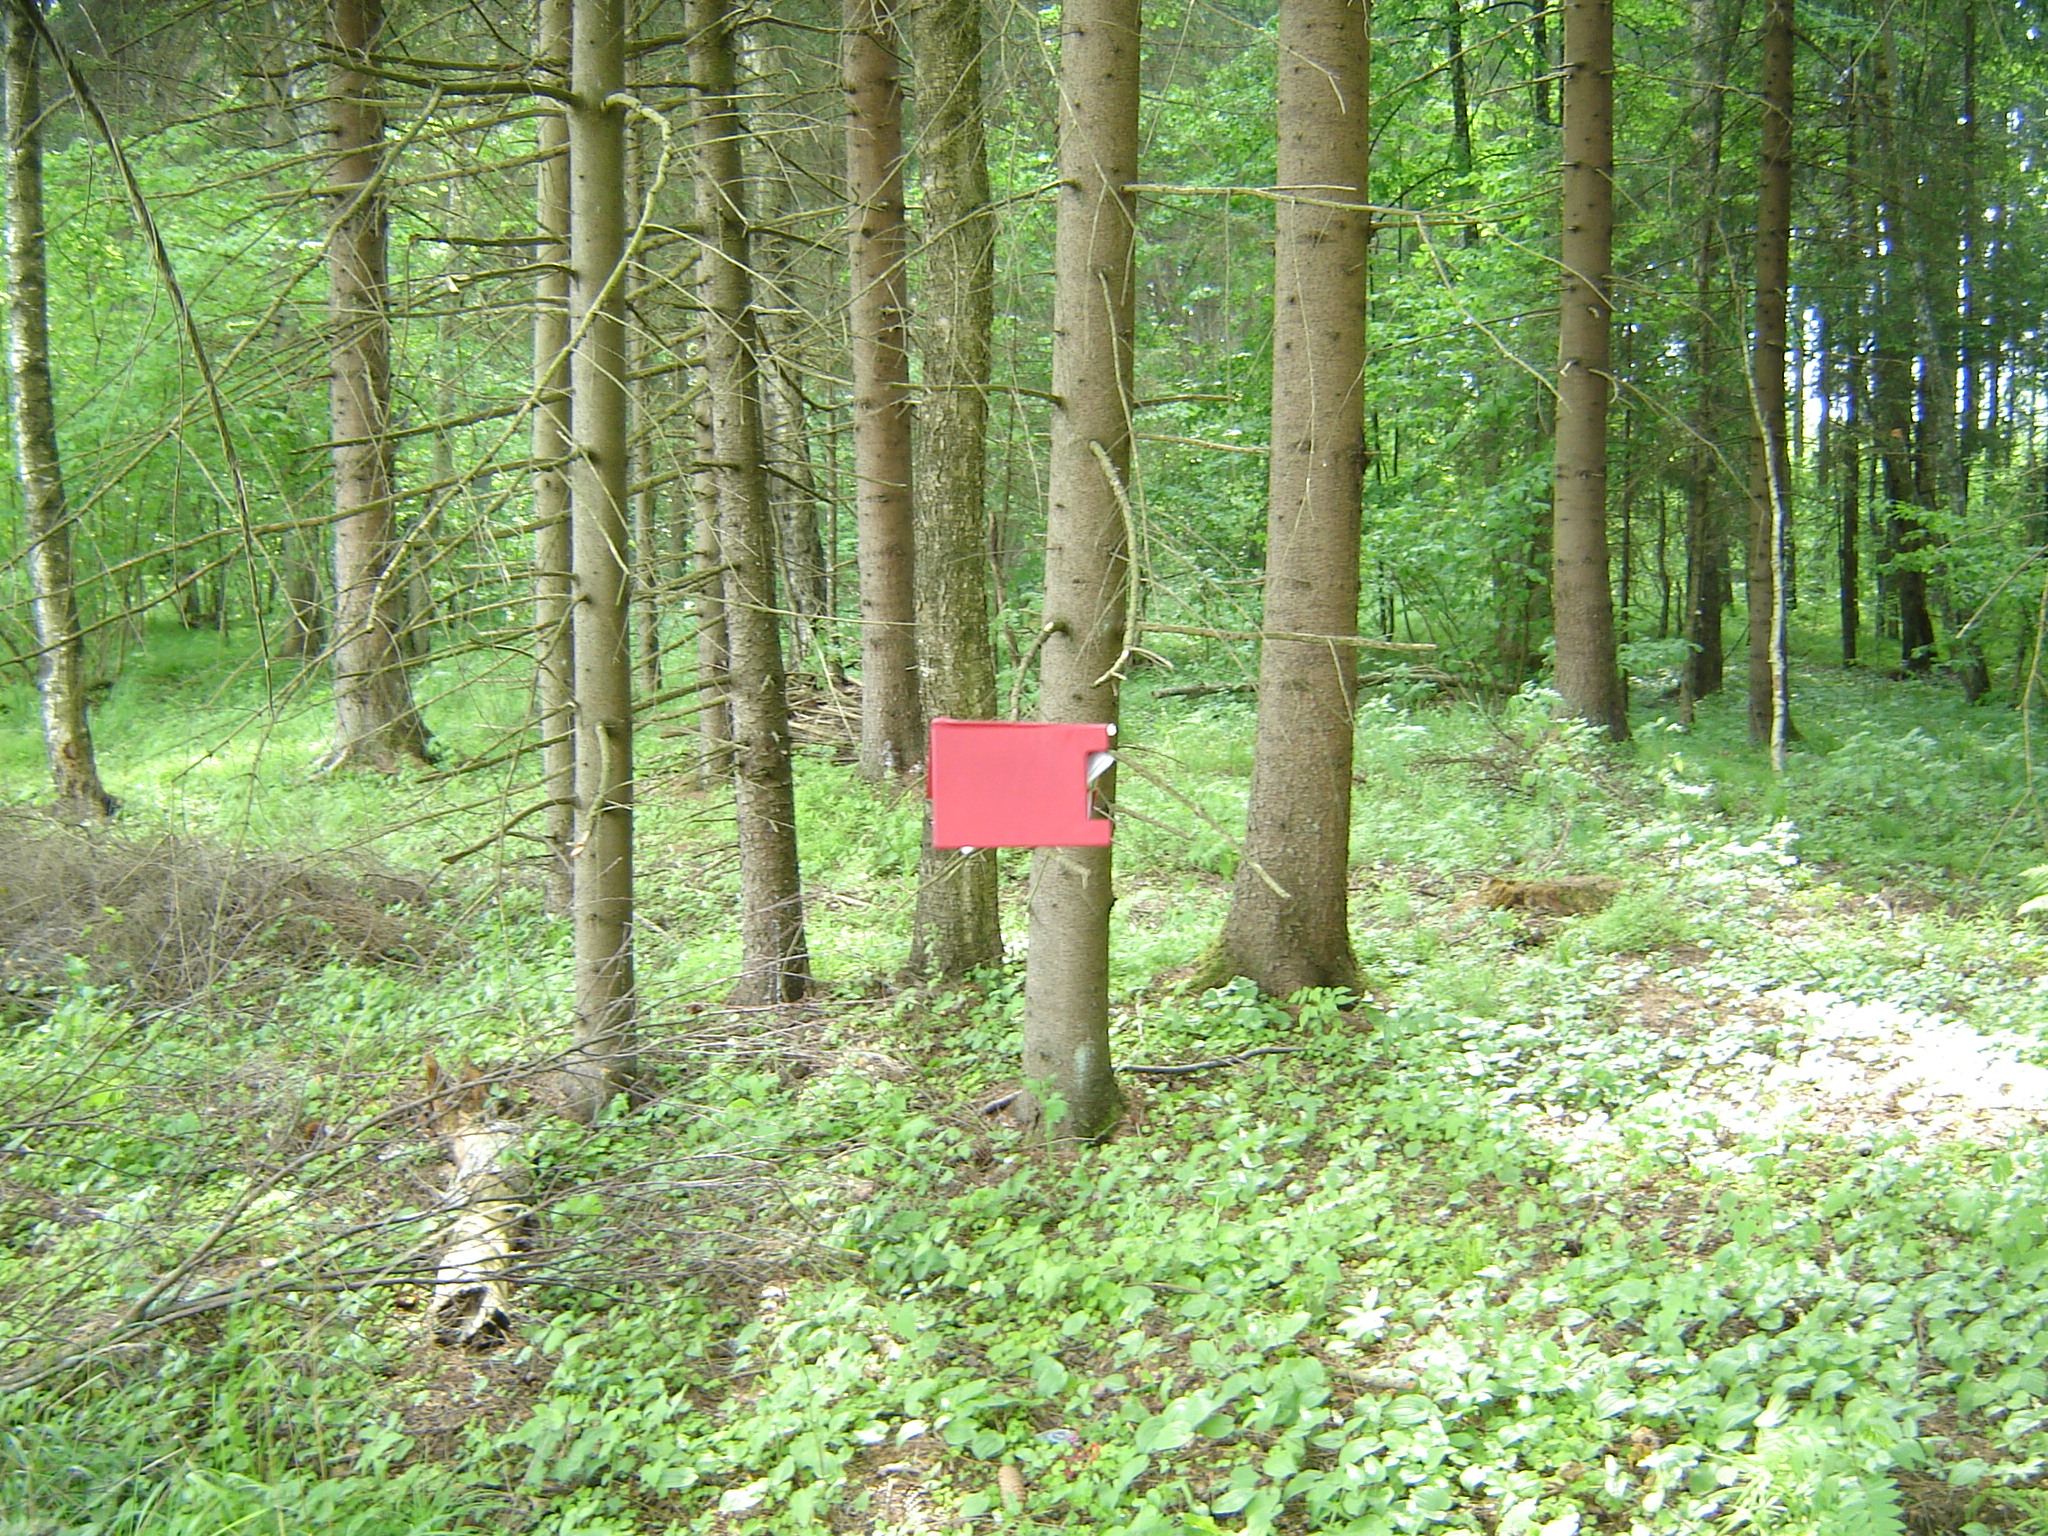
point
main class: Woodland
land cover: Spruce dominated coniferous woodland
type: hemiboreal forest and nemoral coniferous forest and mixed broadleaved-coniferous forest
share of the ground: > 75 %
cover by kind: coniferous forest trees 80 %, broadleaved forest trees 10 %, herbaceous plants 10 %
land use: Forestry
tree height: > 5 m
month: June
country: LT
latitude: 55.9083
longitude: 25.2658
